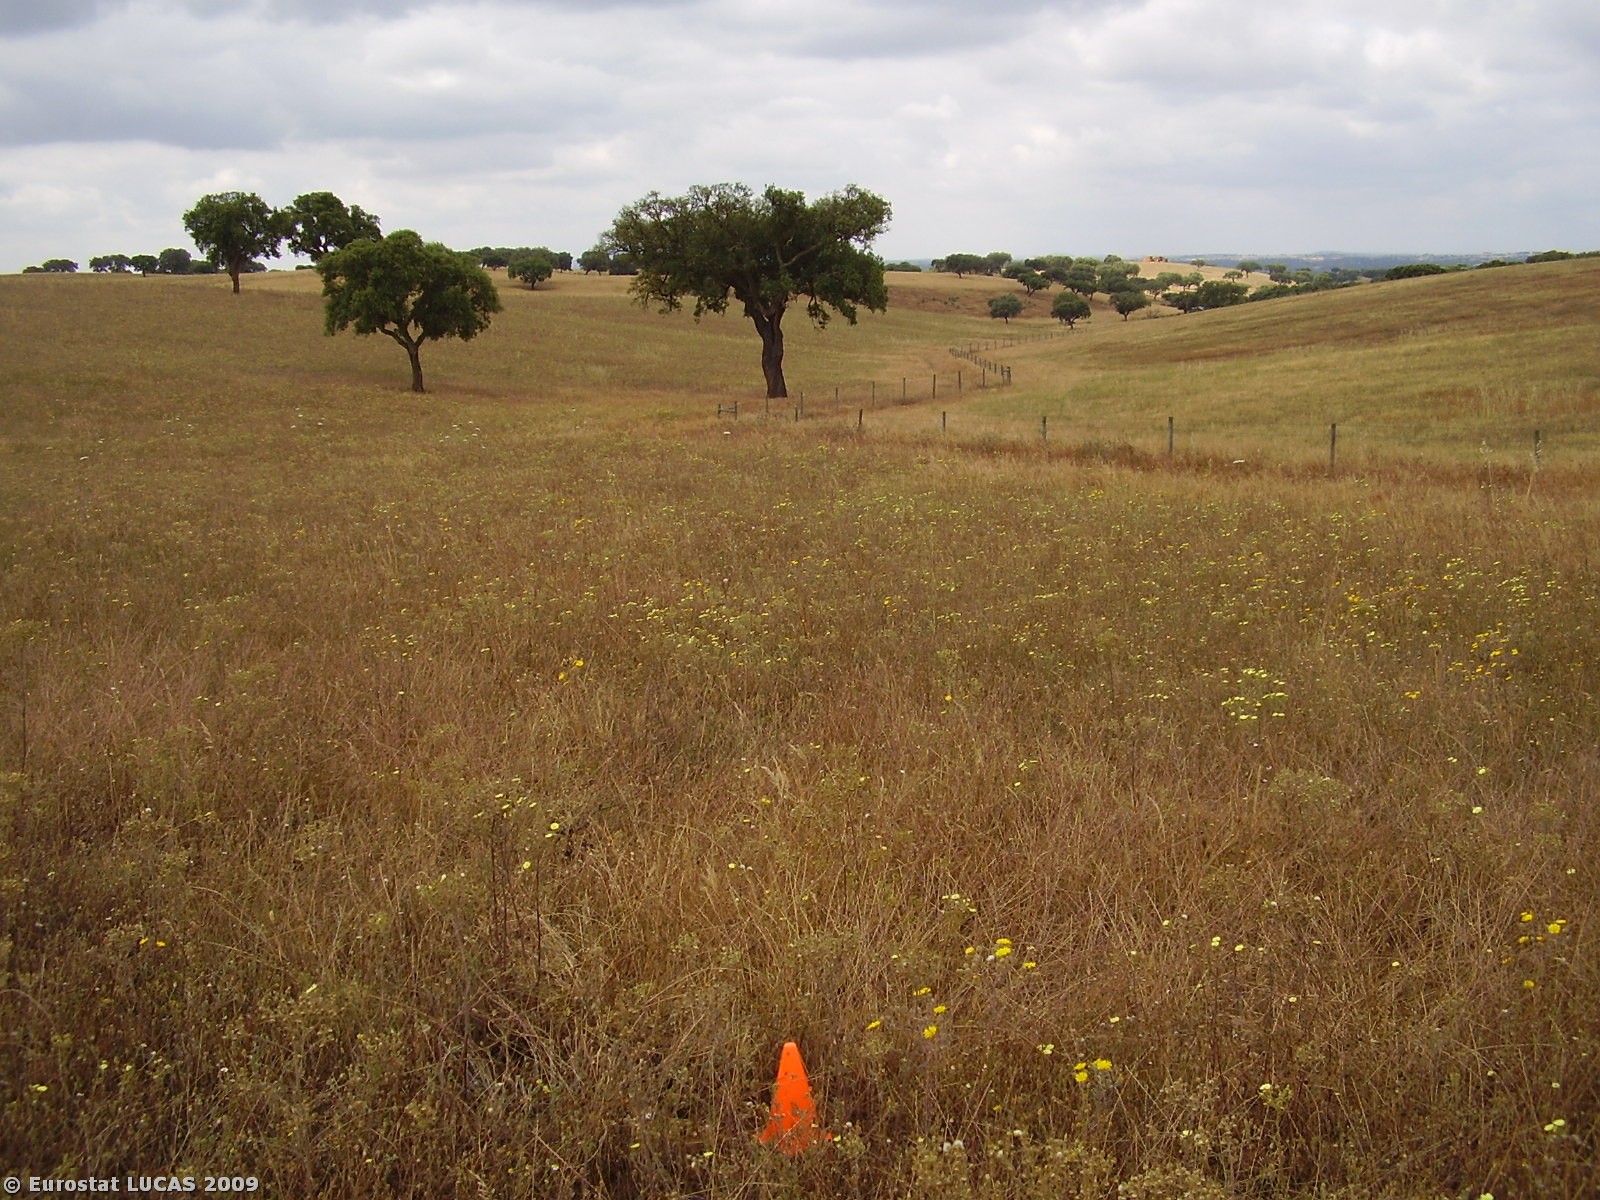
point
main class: Grassland
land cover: Spontaneously vegetated surfaces
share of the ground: 50 - 75 %
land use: Fallow land
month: May
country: PT
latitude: 37.8594
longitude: -7.7418
